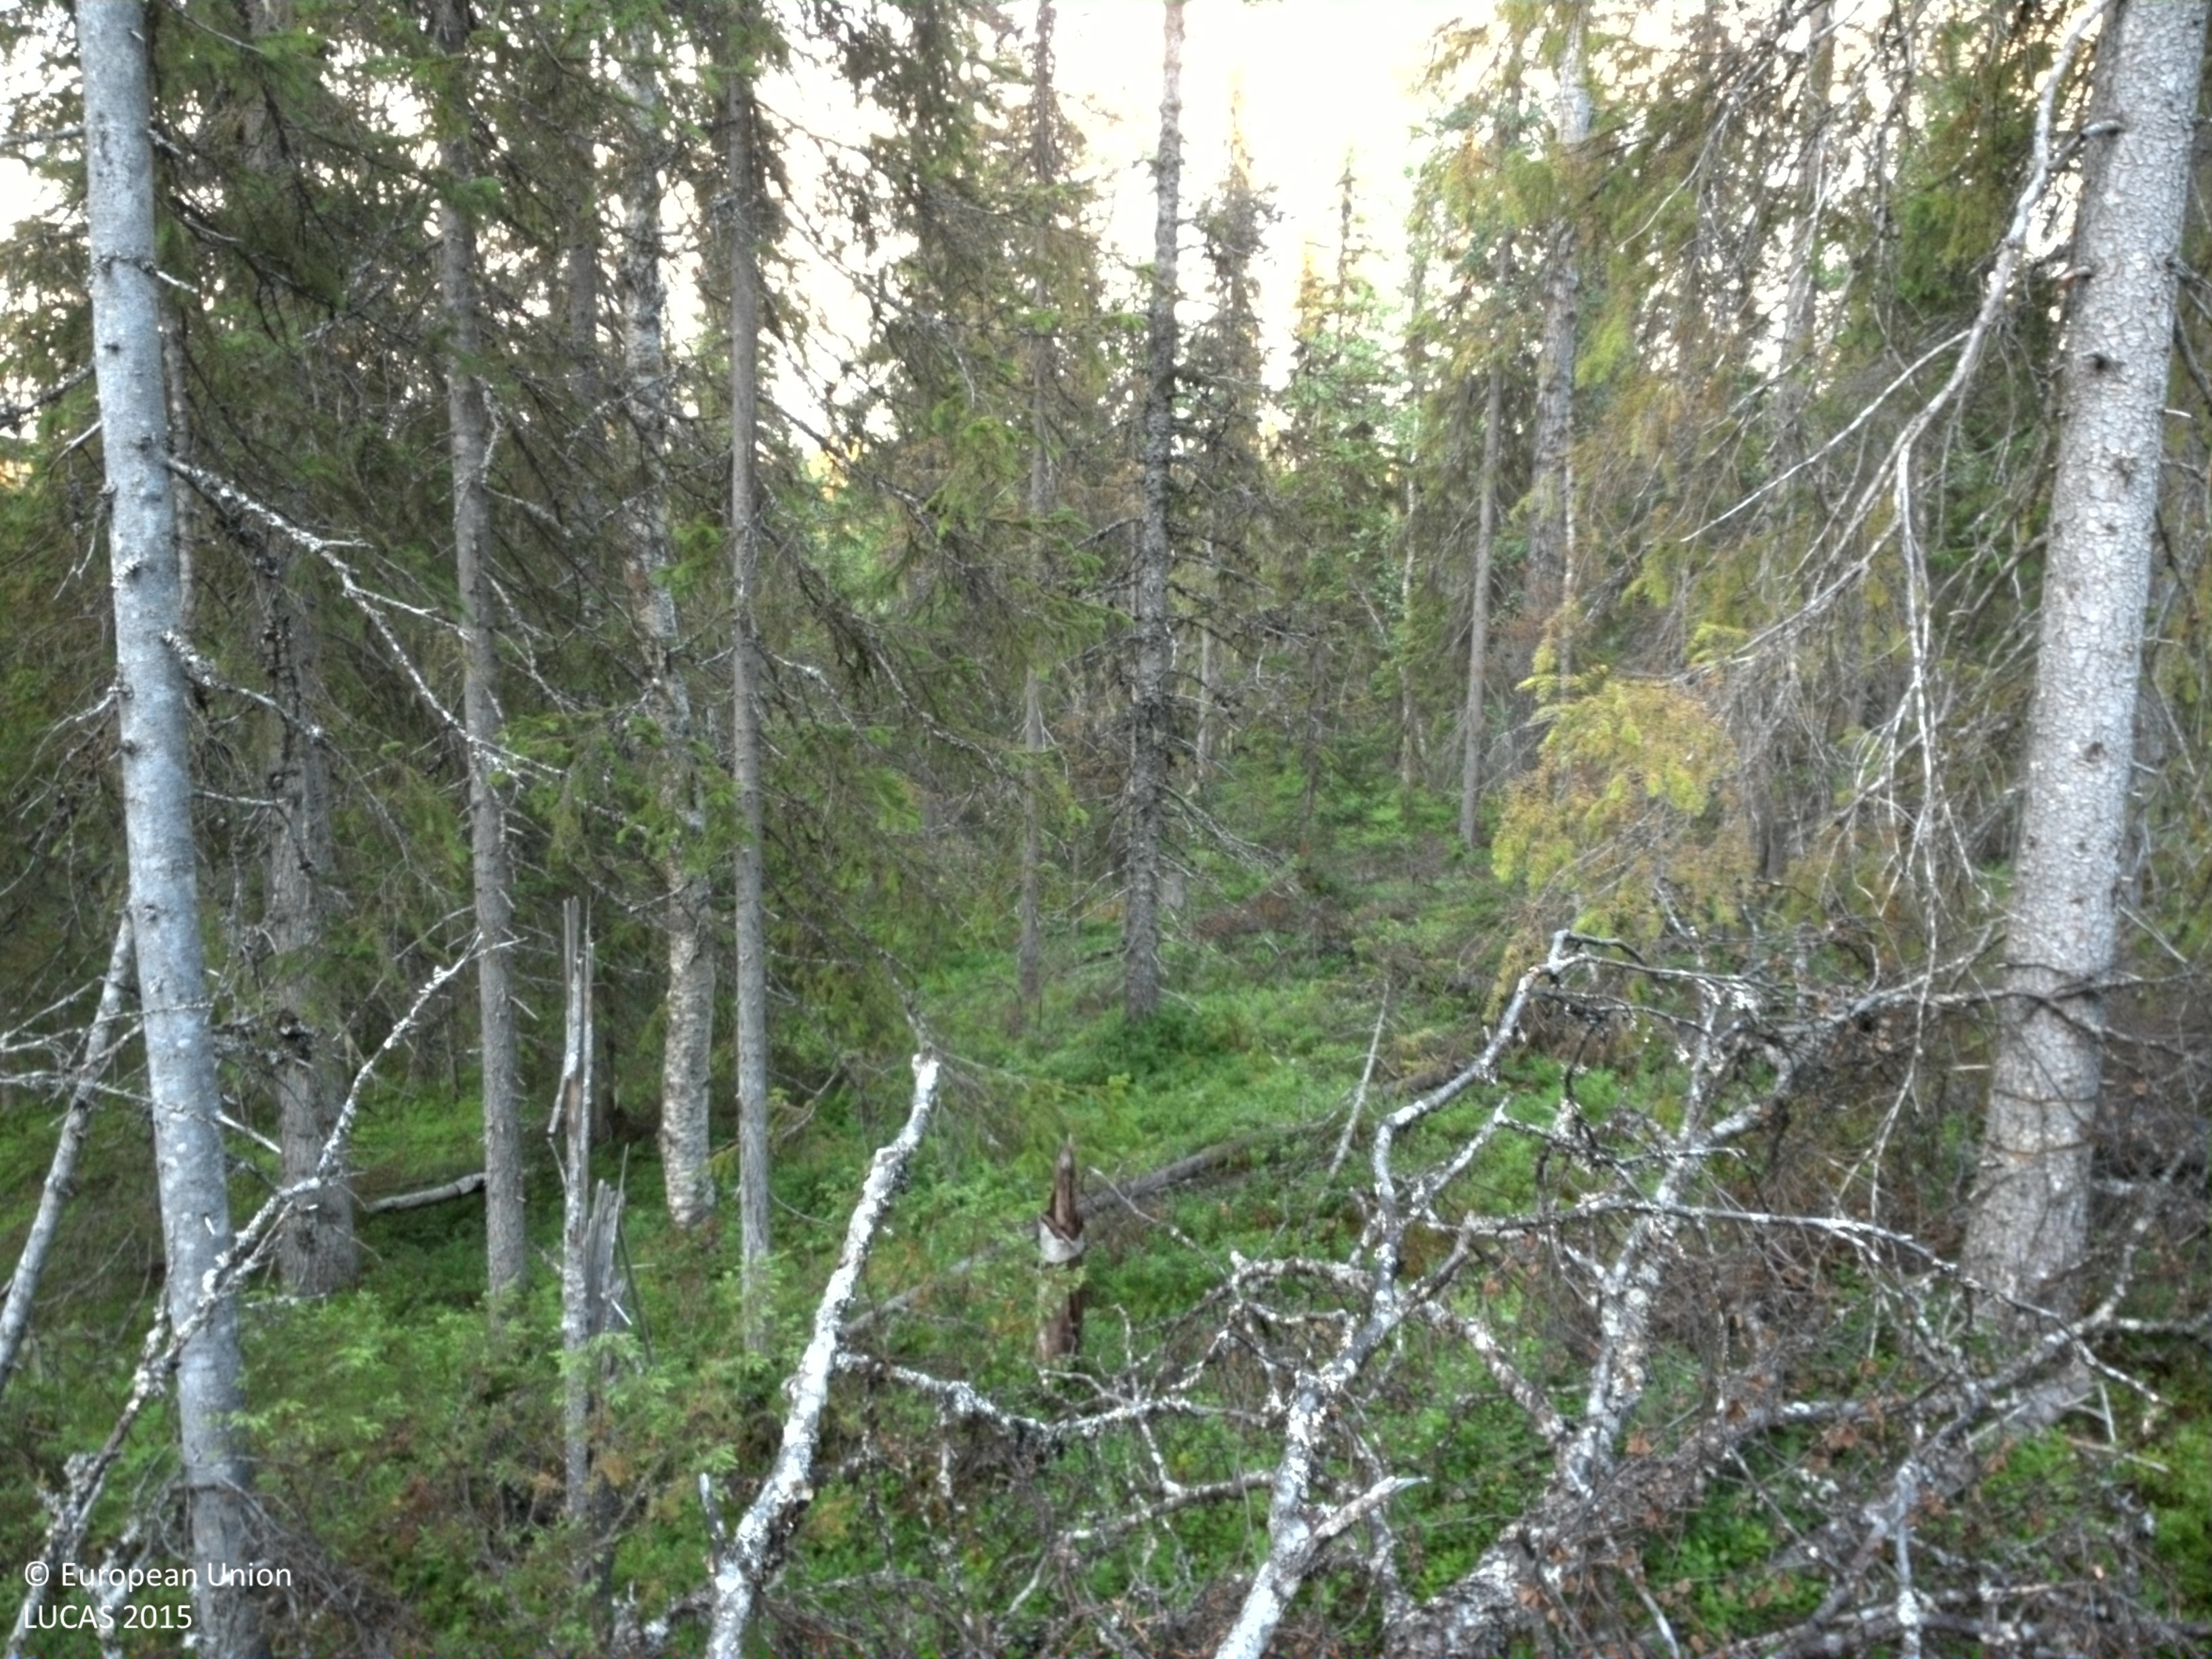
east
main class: Woodland
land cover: Spruce dominated coniferous woodland
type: boreal forest
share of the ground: 10 - 25 %
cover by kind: shrubs 50 %, coniferous forest trees 20 %, lichens and mosses 15 %, herbaceous plants 5 %
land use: Forestry
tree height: > 5 m
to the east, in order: Spruce dominated coniferous woodland
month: August
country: SE
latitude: 64.8589
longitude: 16.1473
